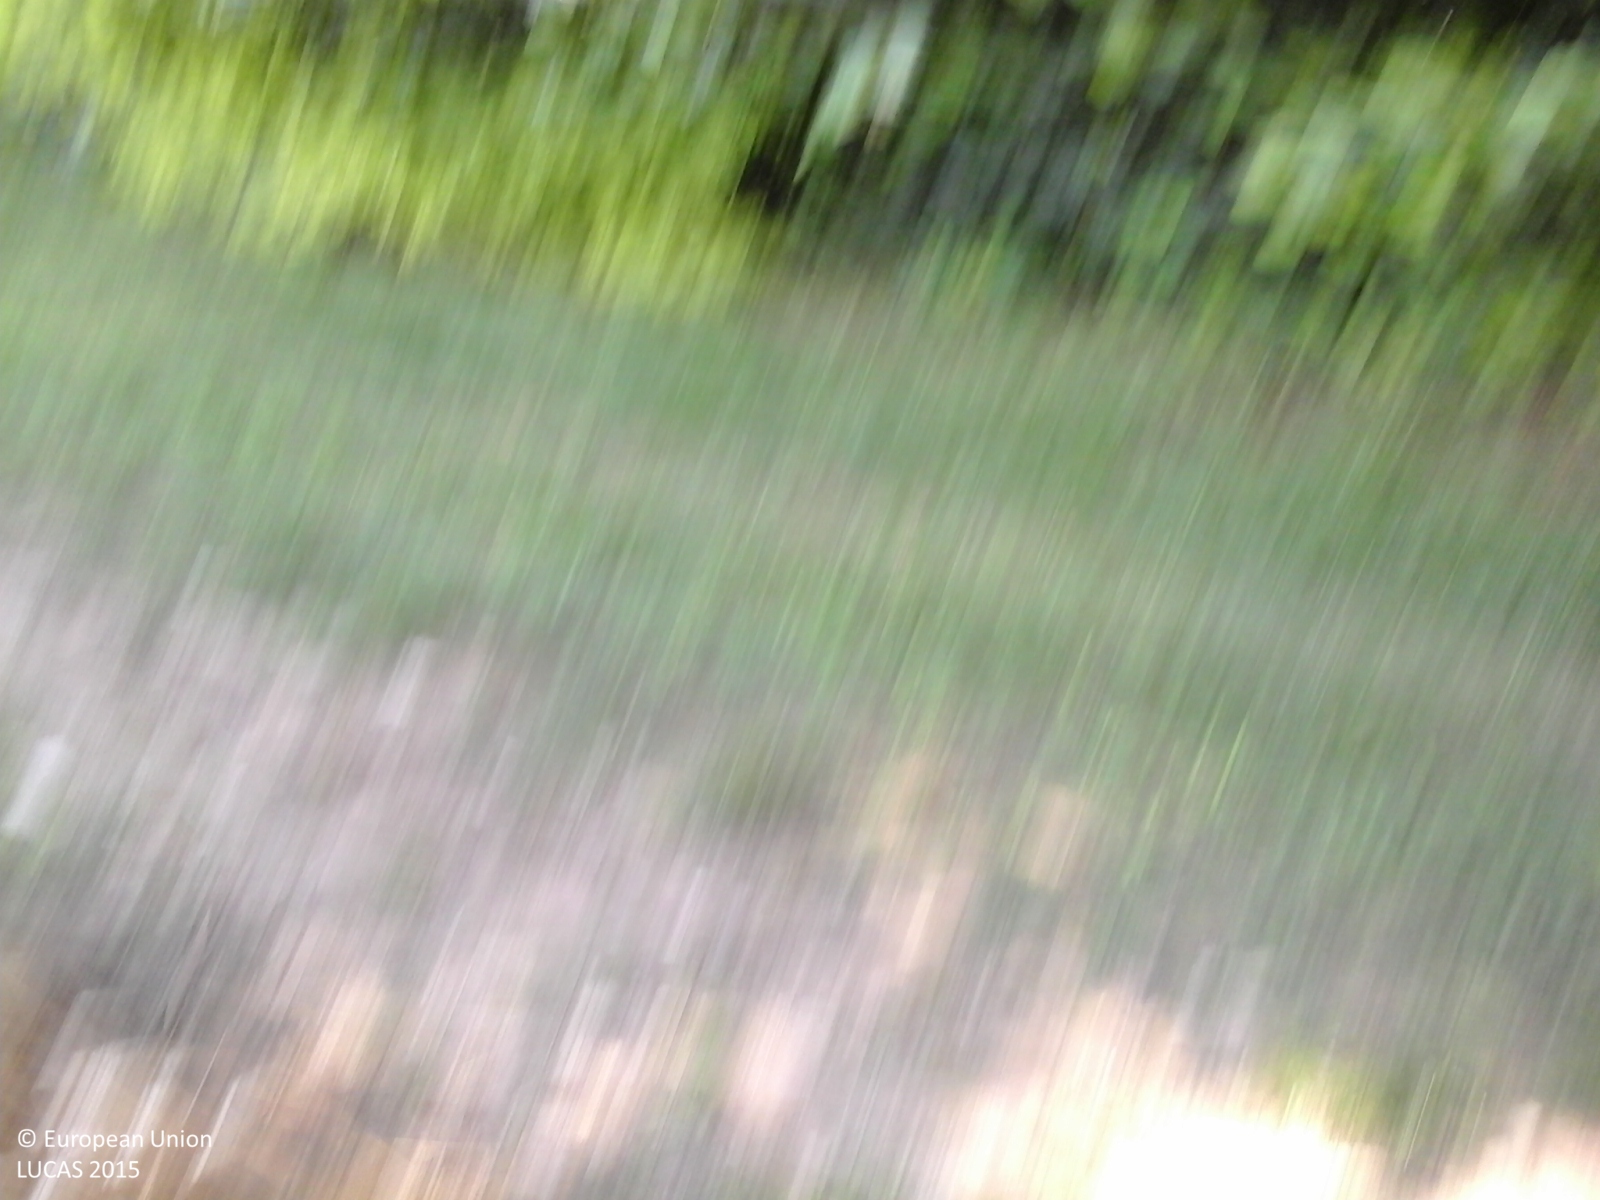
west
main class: Cropland
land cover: Common wheat
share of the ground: > 75 %
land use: Agriculture (excluding fallow land and kitchen gardens)
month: June
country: IT
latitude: 45.8910
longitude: 12.4324
